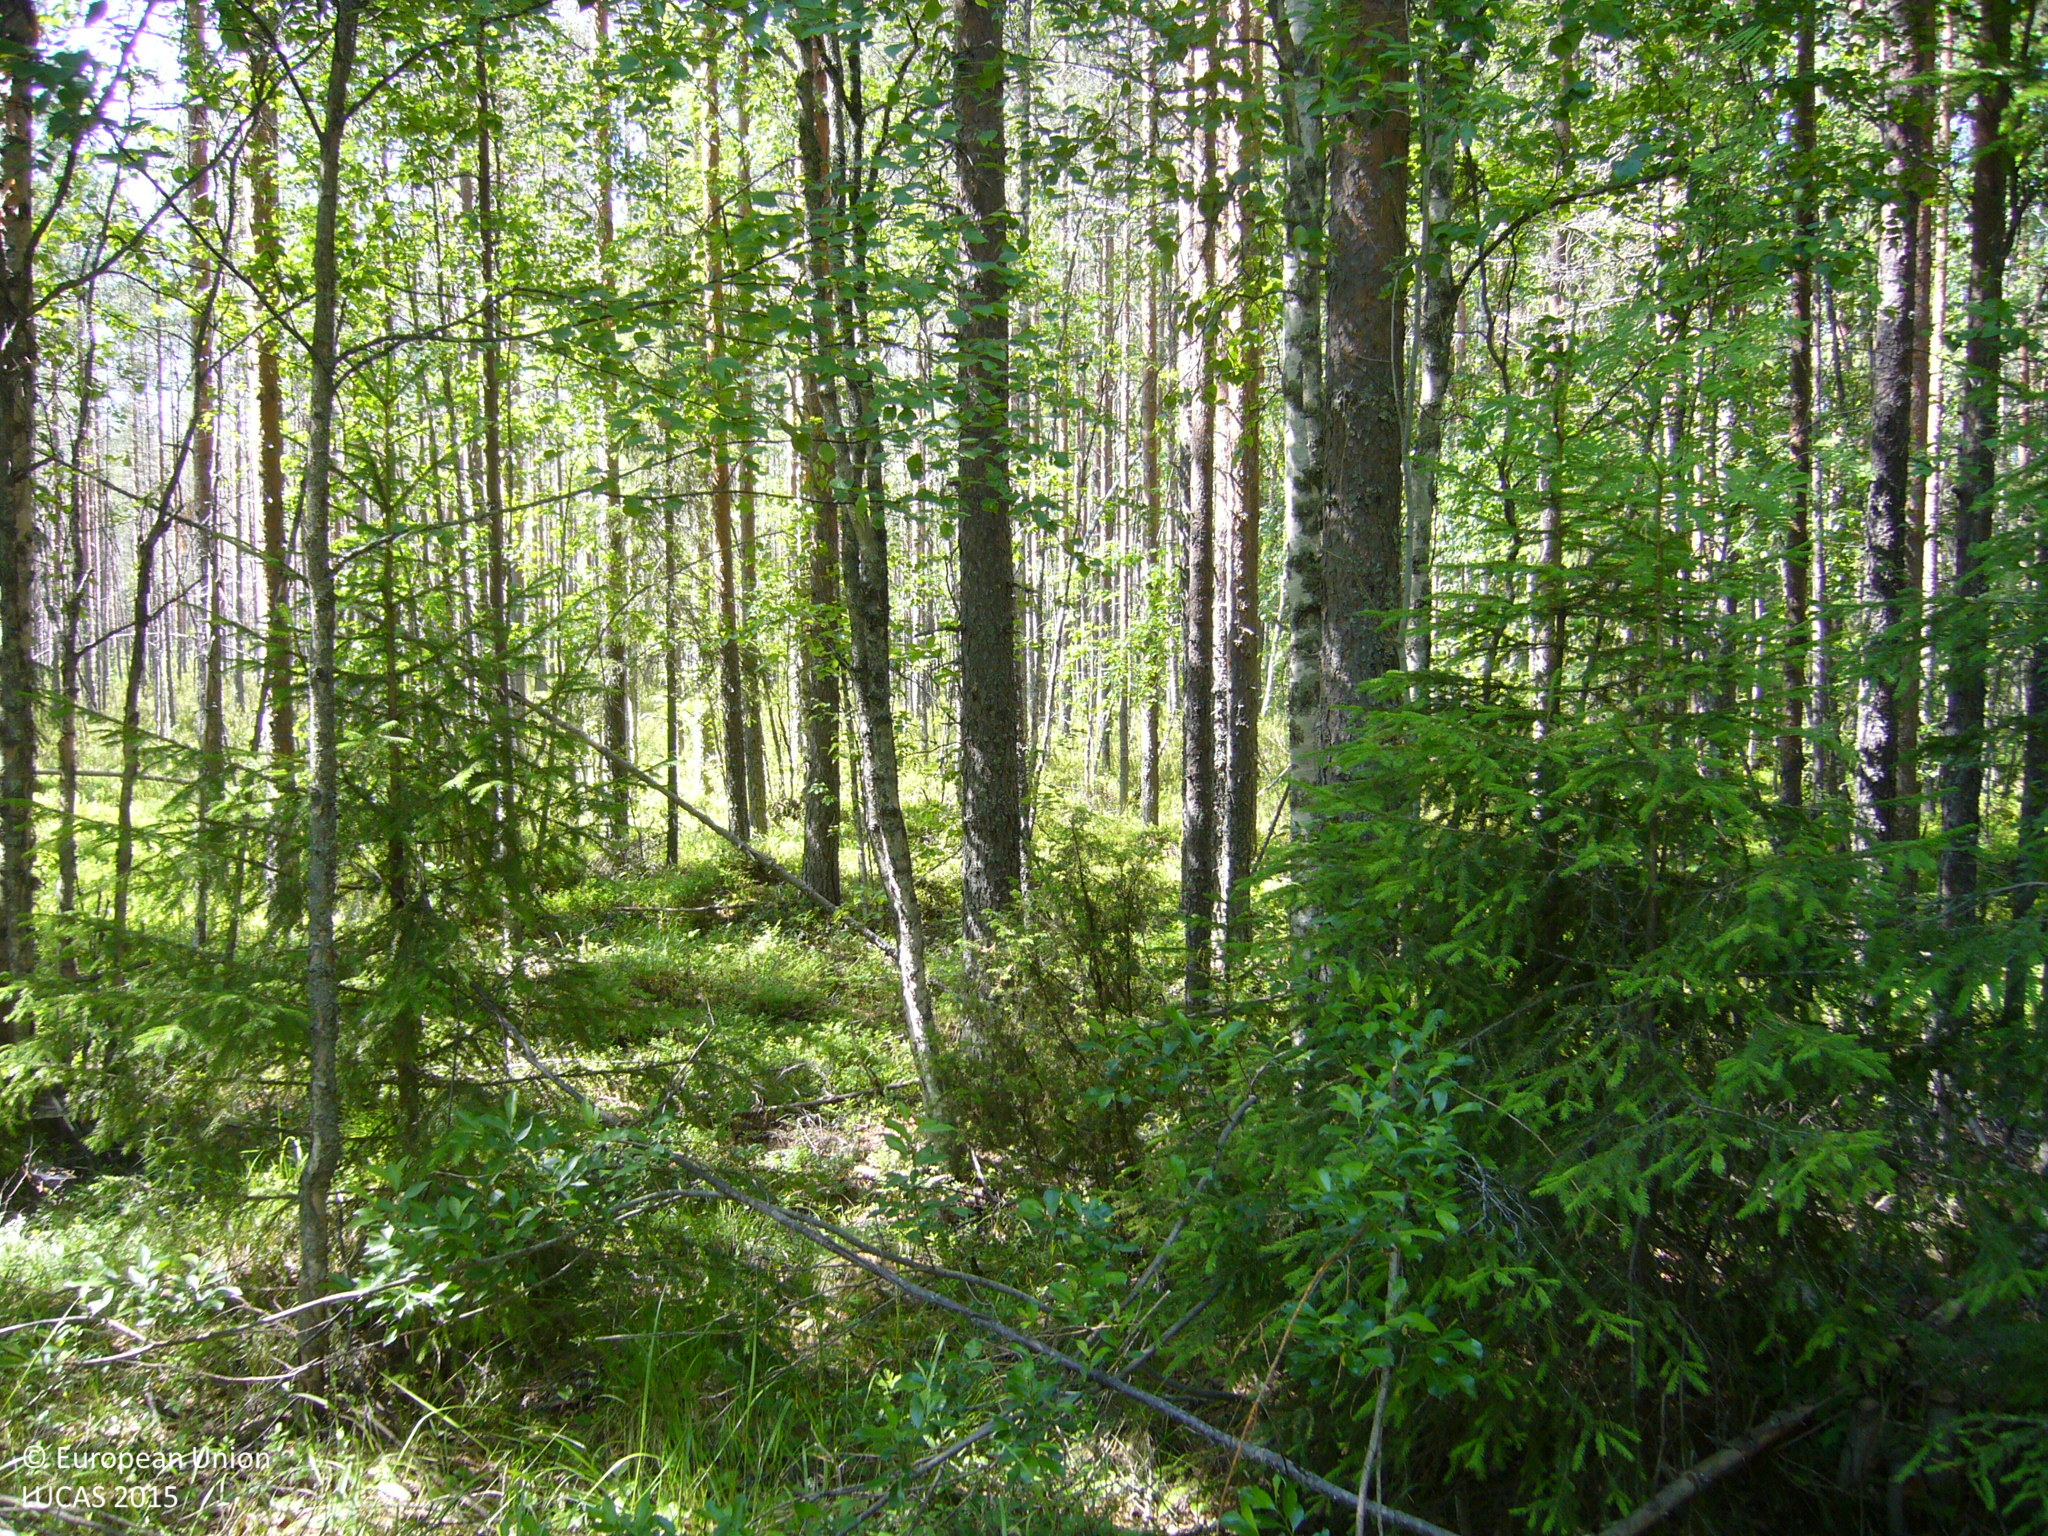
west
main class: Woodland
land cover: Other mixed woodland
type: boreal forest
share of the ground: > 75 %
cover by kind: broadleaved forest trees 50 %, coniferous forest trees 30 %, shrubs 20 %
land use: Forestry
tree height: > 5 m
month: July
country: FI
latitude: 63.3464
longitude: 25.9179
